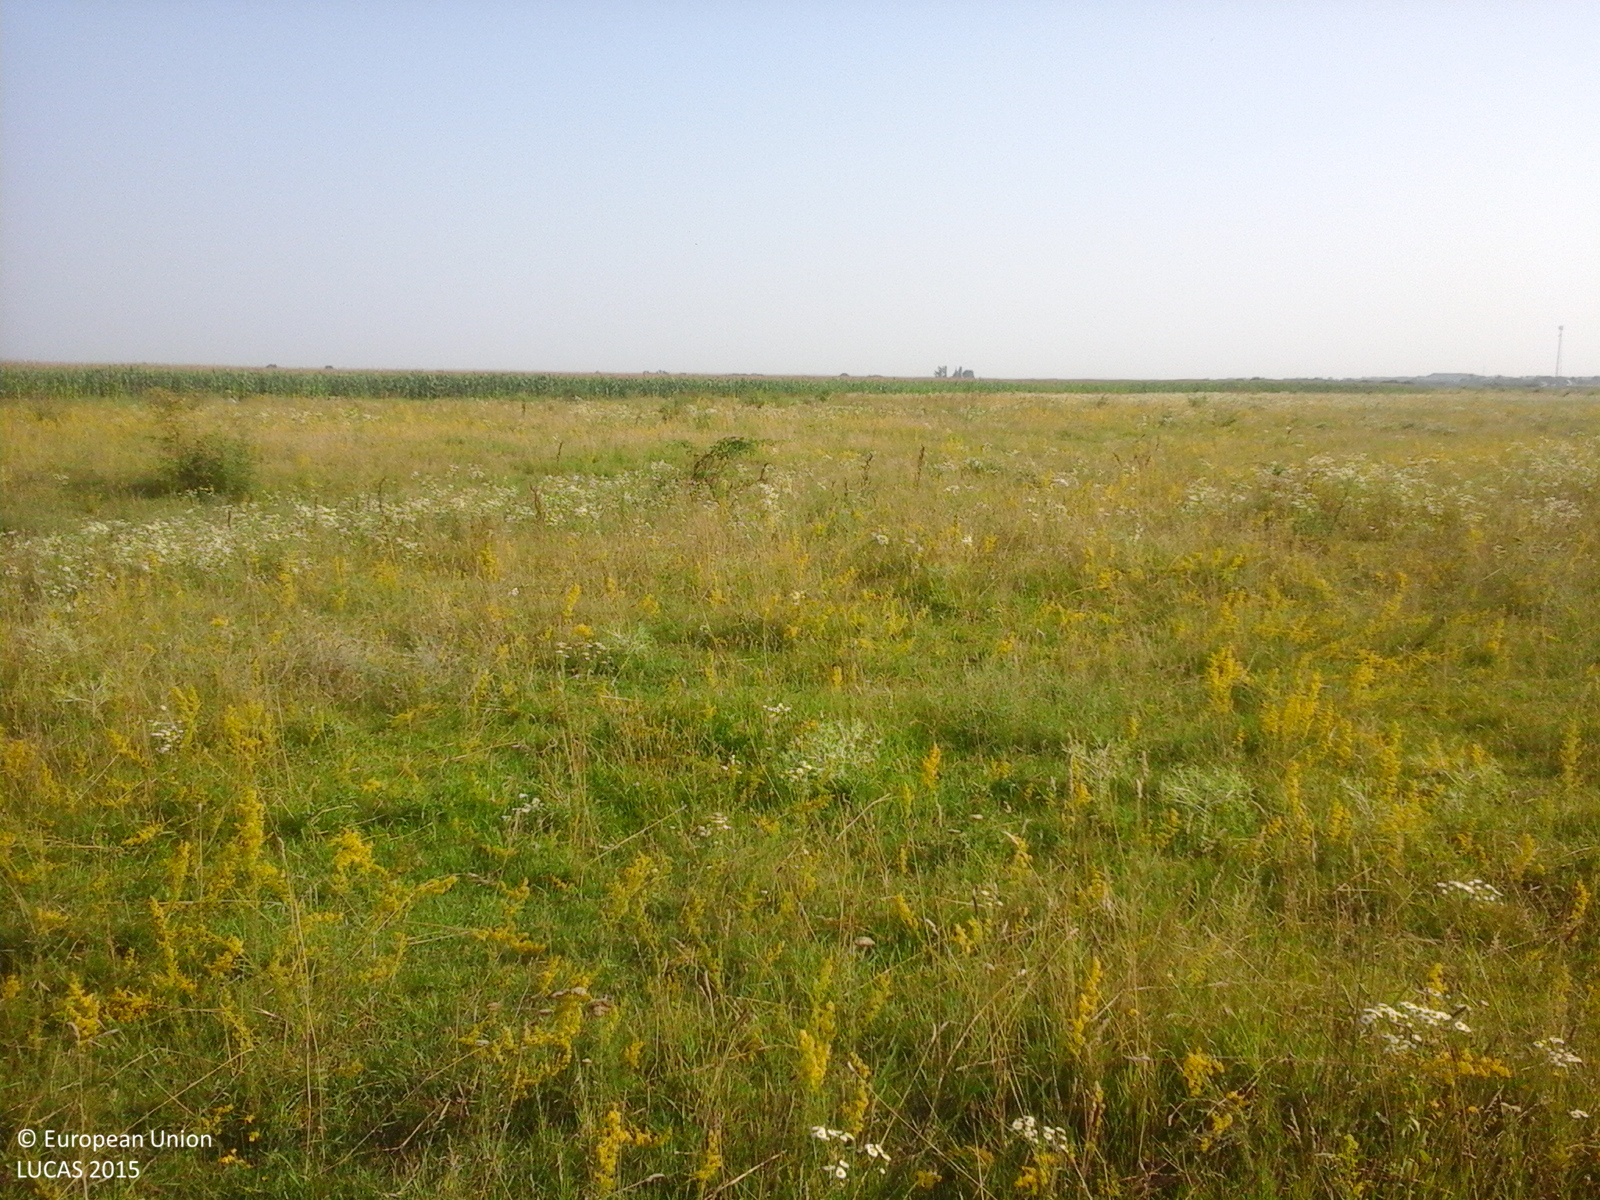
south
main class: Grassland
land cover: Grassland with sparse tree/shrub cover
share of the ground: > 75 %
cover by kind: herbaceous plants 85 %, shrubs 10 %, broadleaved forest trees 5 %
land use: Agriculture (excluding fallow land and kitchen gardens)
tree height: > 5 m
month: July
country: RO
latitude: 44.6675
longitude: 25.4681
